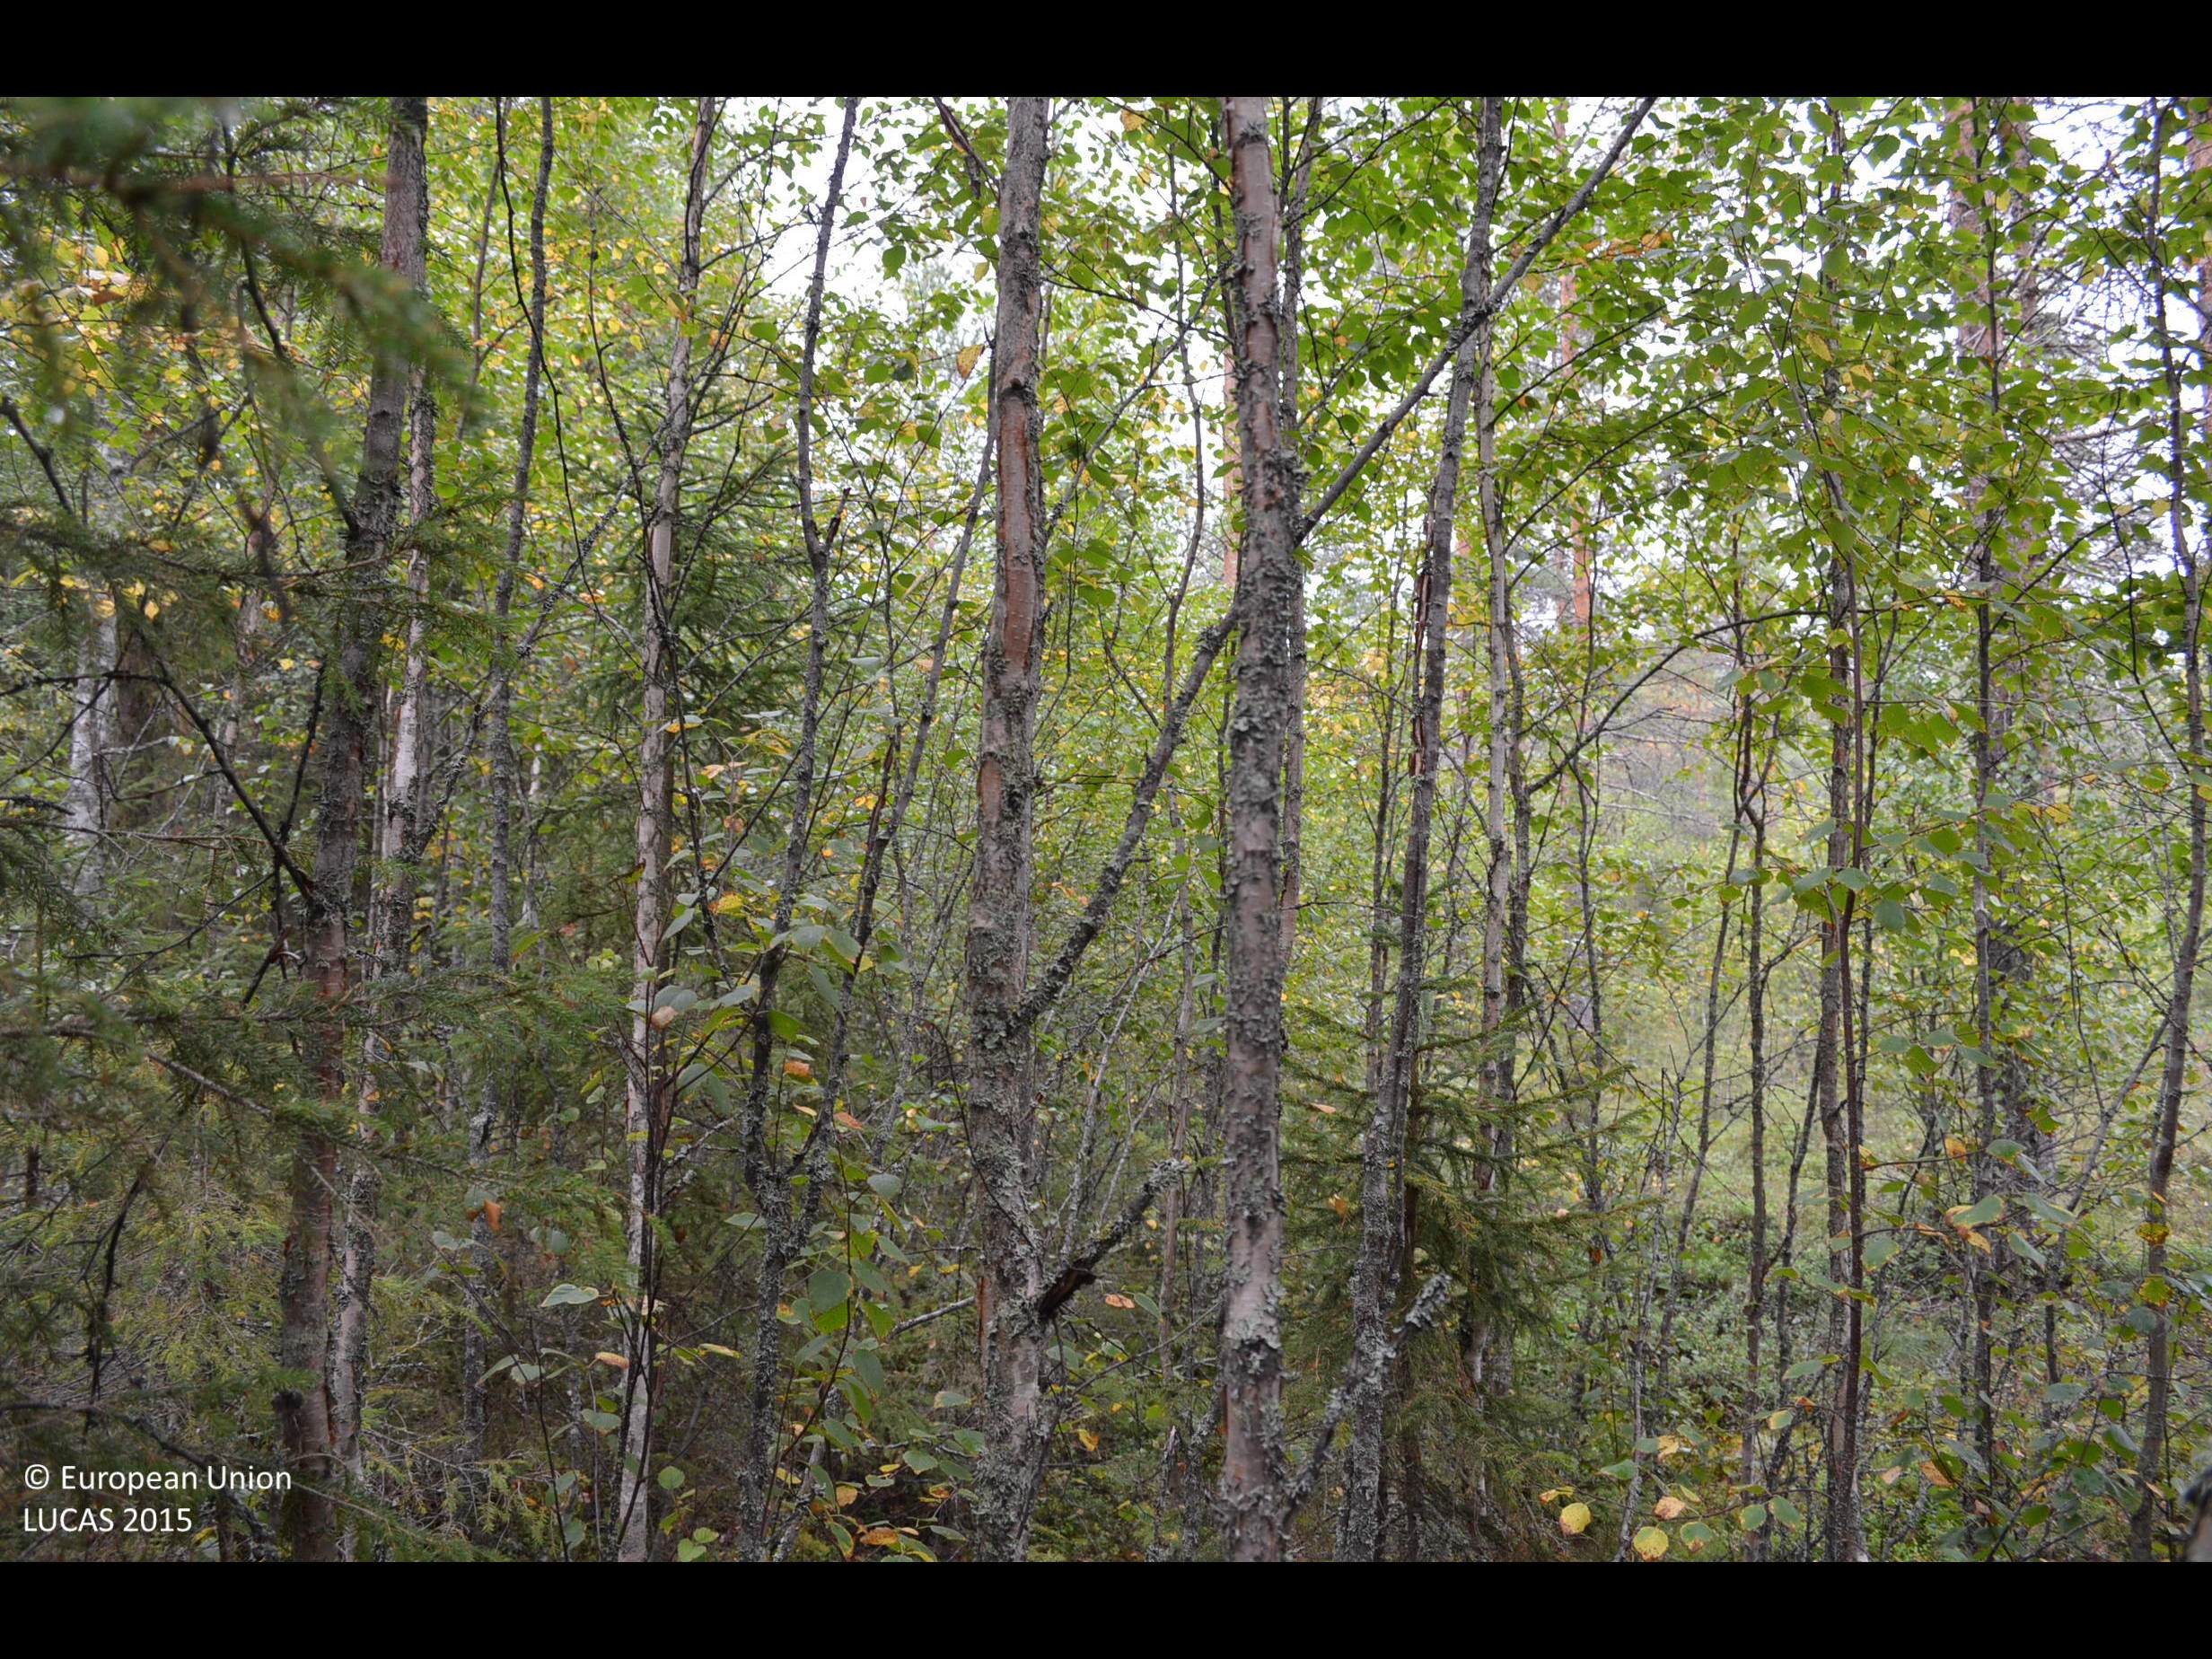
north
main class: Woodland
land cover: Other mixed woodland
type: boreal forest
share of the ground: > 75 %
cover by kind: broadleaved forest trees 40 %, coniferous forest trees 35 %, shrubs 20 %, lichens and mosses 5 %
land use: Forestry
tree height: > 5 m
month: August
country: FI
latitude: 62.6620
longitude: 24.4727
